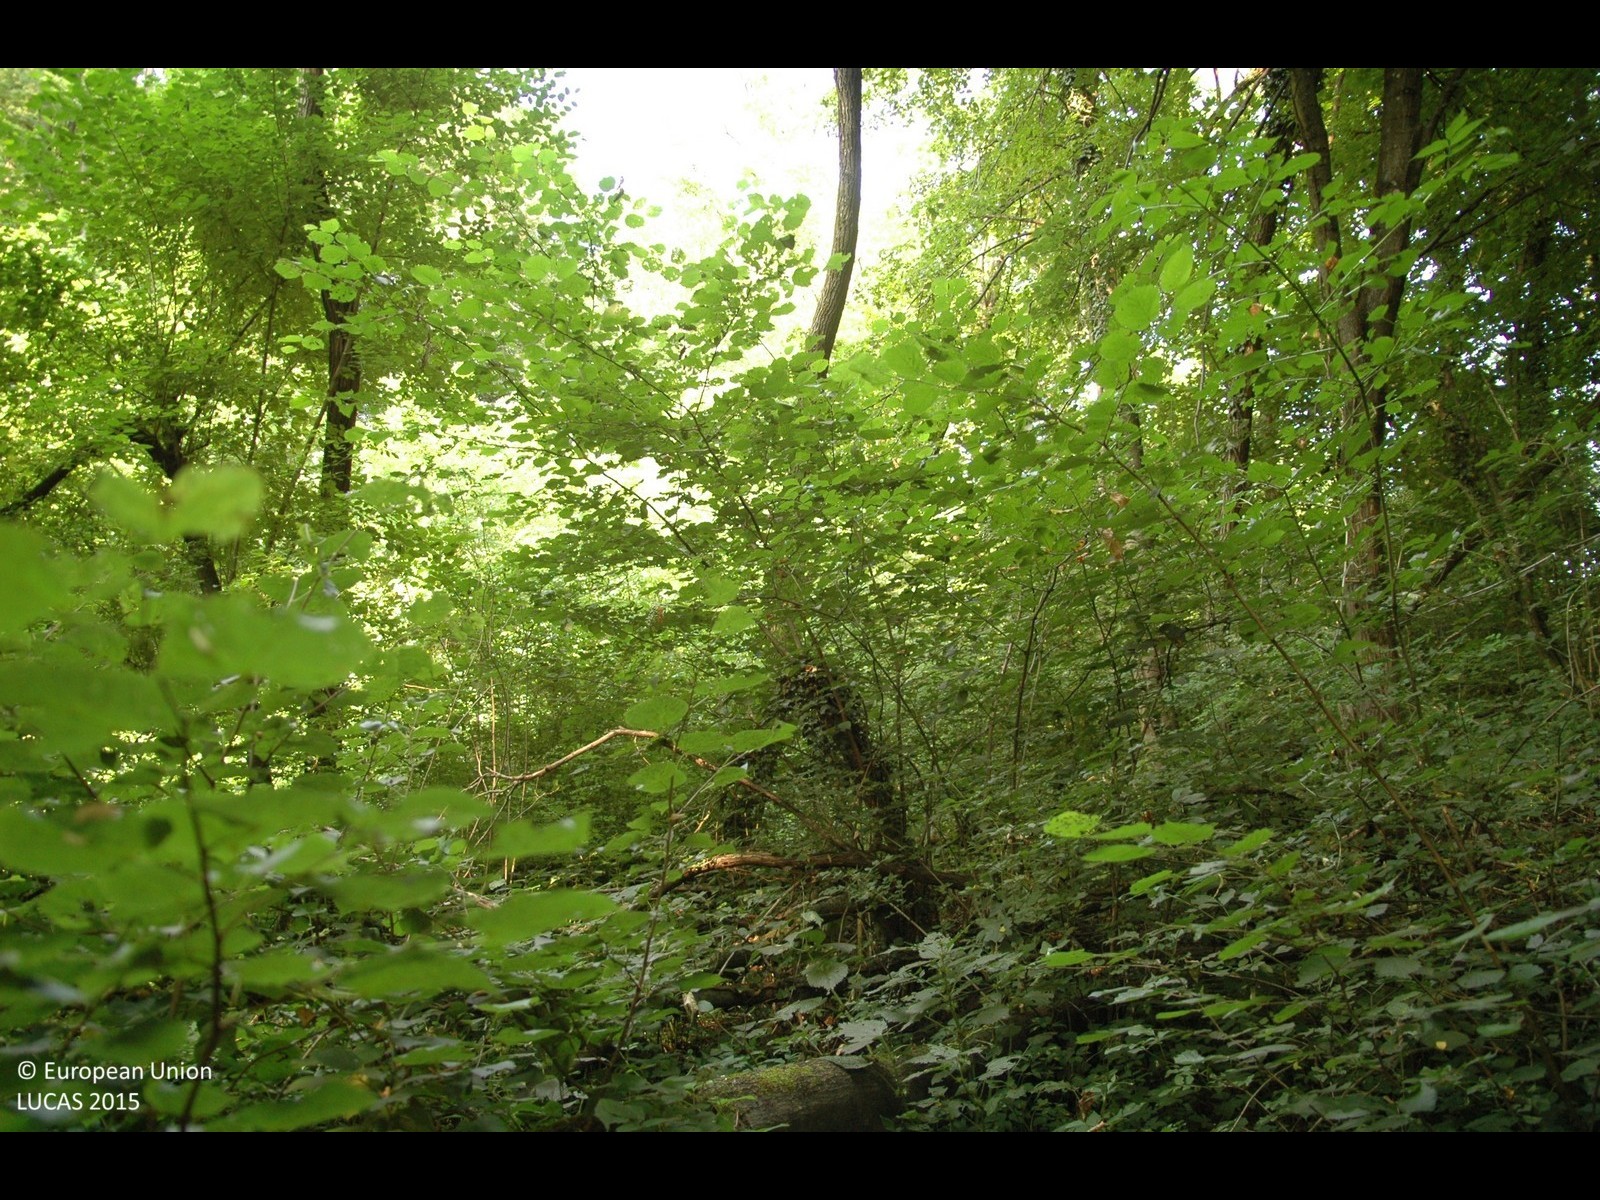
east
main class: Woodland
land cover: Broadleaved woodland
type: mesophytic deciduous forest
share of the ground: > 75 %
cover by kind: broadleaved forest trees 100 %
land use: Forestry
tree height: > 5 m
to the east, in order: Broadleaved woodland; Vineyards; Paved roads, cycling and walking lanes; Grassland without tree/shrub cover; Single bushes/trees; Tracks; Shrubland with sparse tree cover
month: July
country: HR
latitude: 46.0305
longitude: 16.1356
